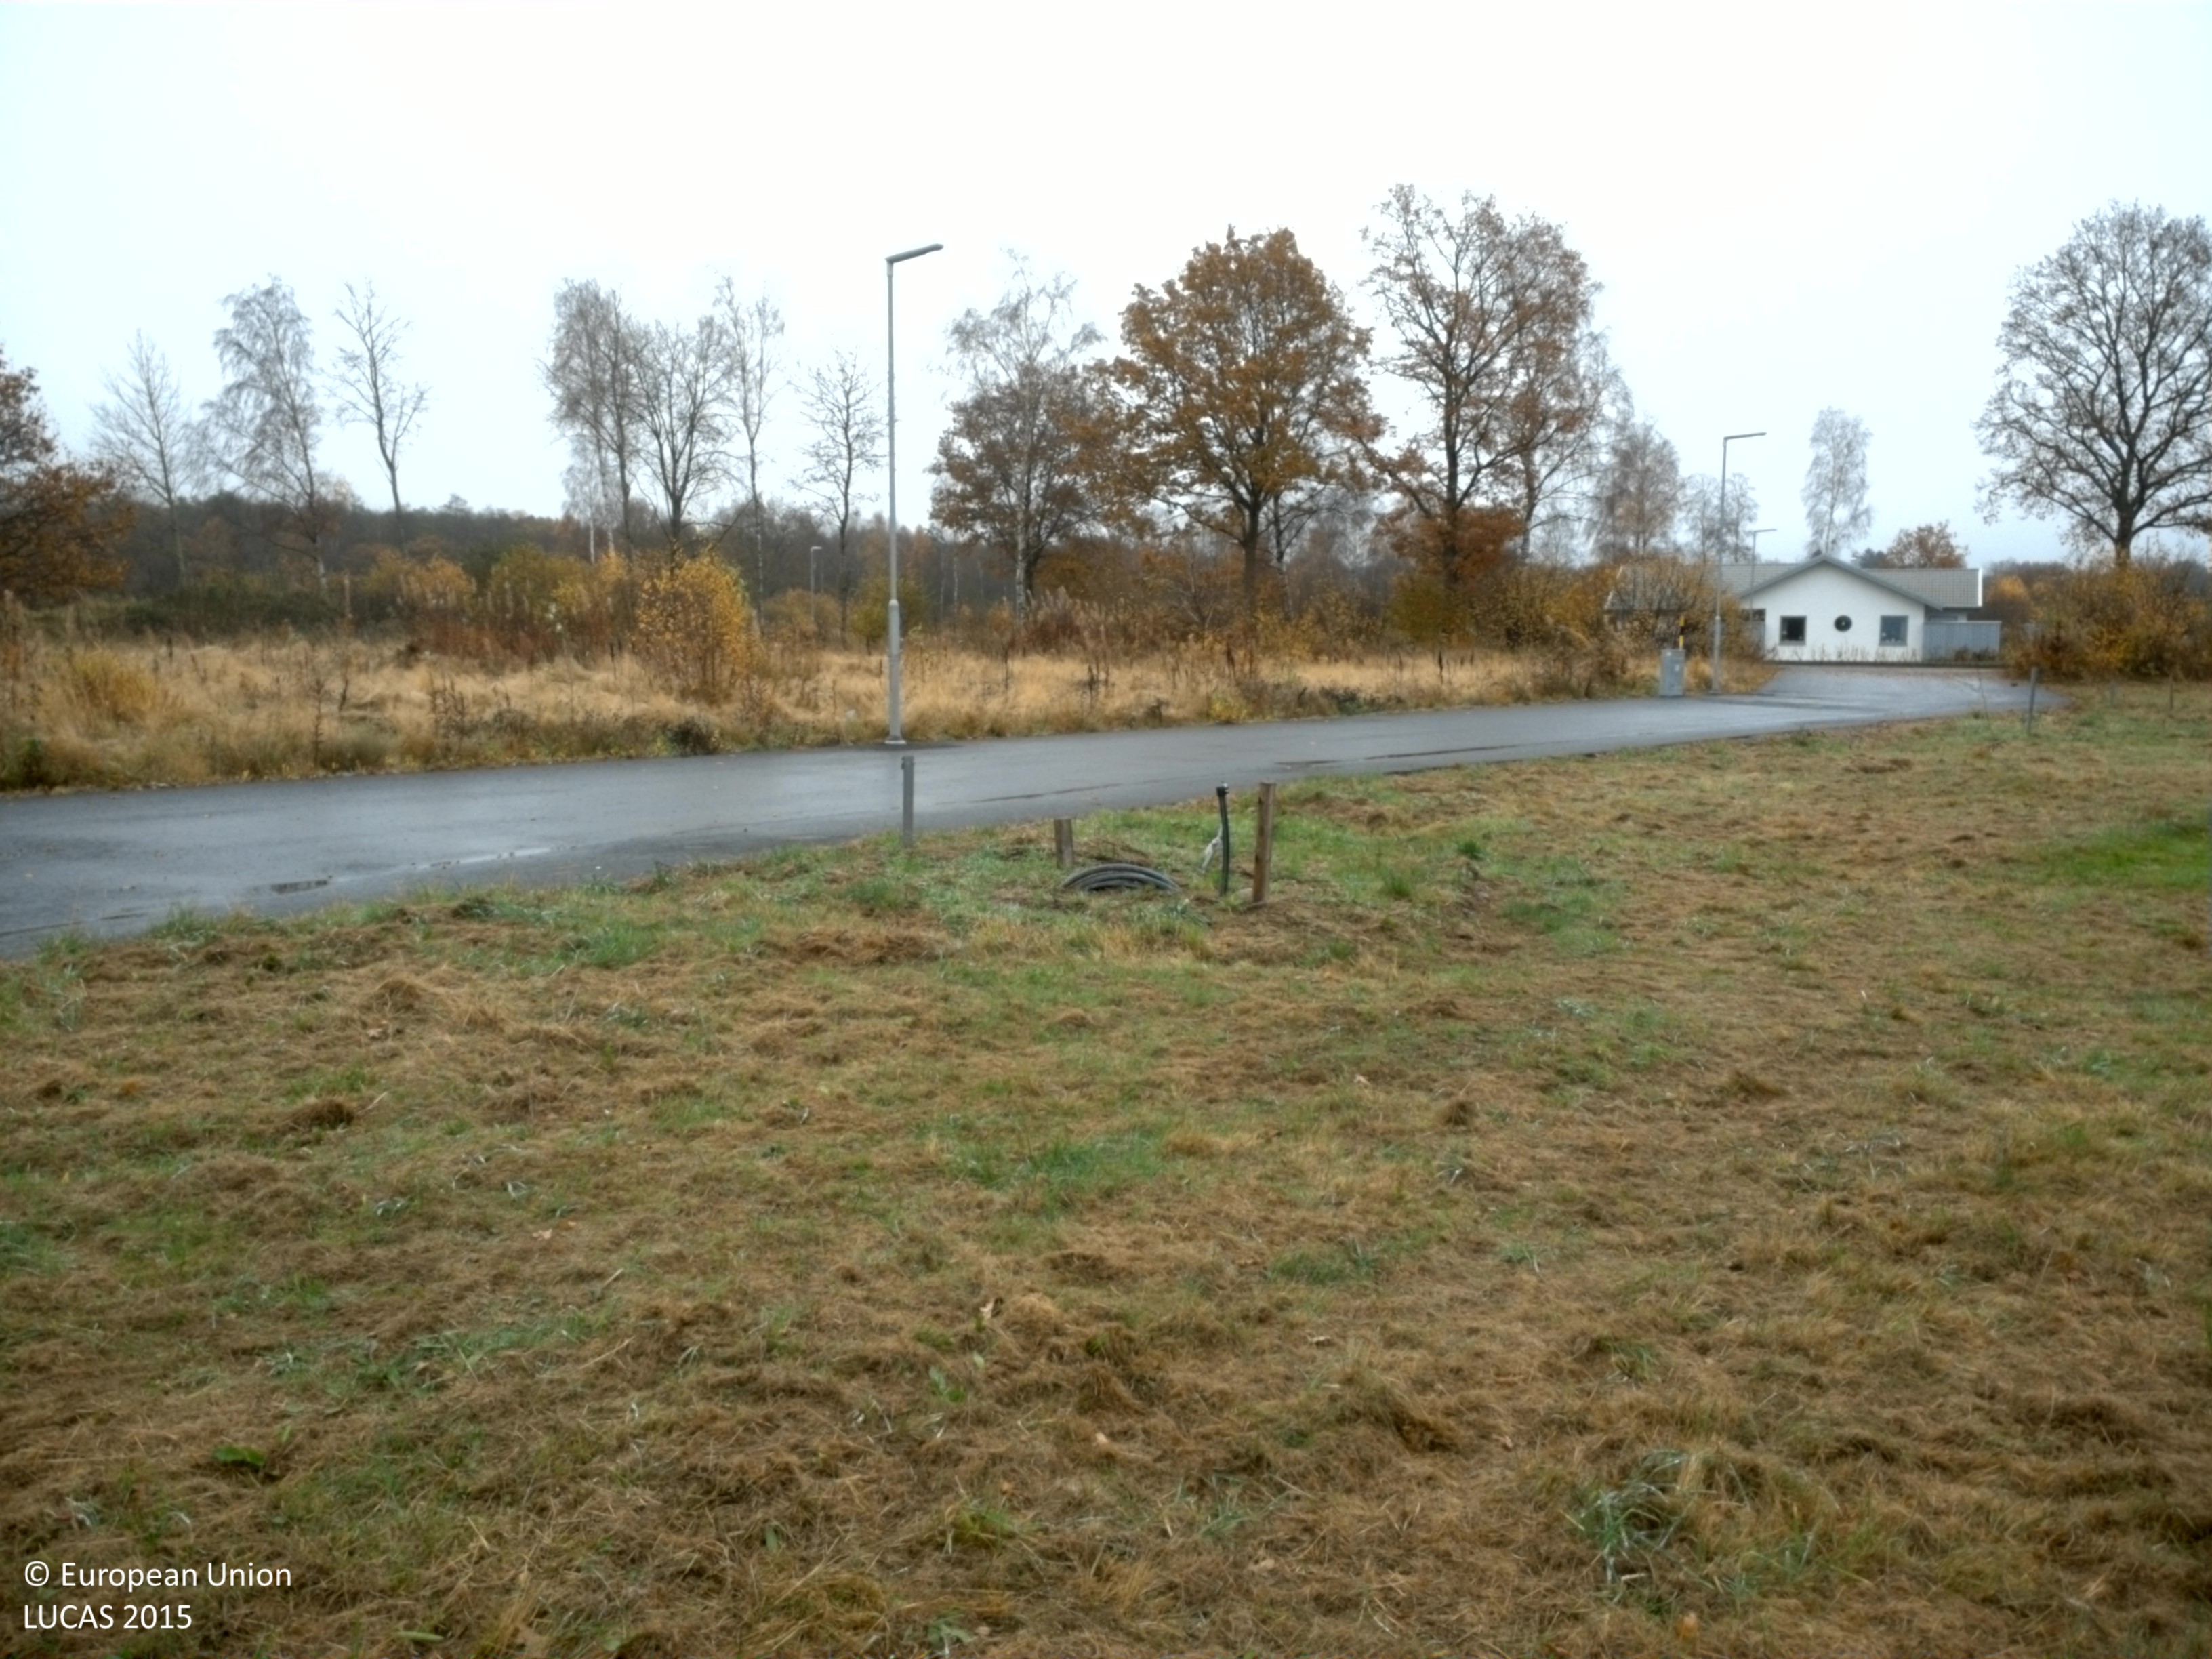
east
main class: Grassland
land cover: Grassland without tree/shrub cover
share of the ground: > 75 %
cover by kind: herbaceous plants 100 %
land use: Residential
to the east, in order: Grassland without tree/shrub cover; Paved roads, cycling and walking lanes; Grassland with sparse tree/shrub cover; Broadleaved woodland; Dry stone walls; Grassland with sparse tree/shrub cover; Paved roads, cycling and walking lanes; Shrubland with sparse tree cover; Broadleaved woodland; Grassland without tree/shrub cover; Ditches and canals; Broadleaved woodland
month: November
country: SE
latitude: 56.0066
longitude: 13.0928
